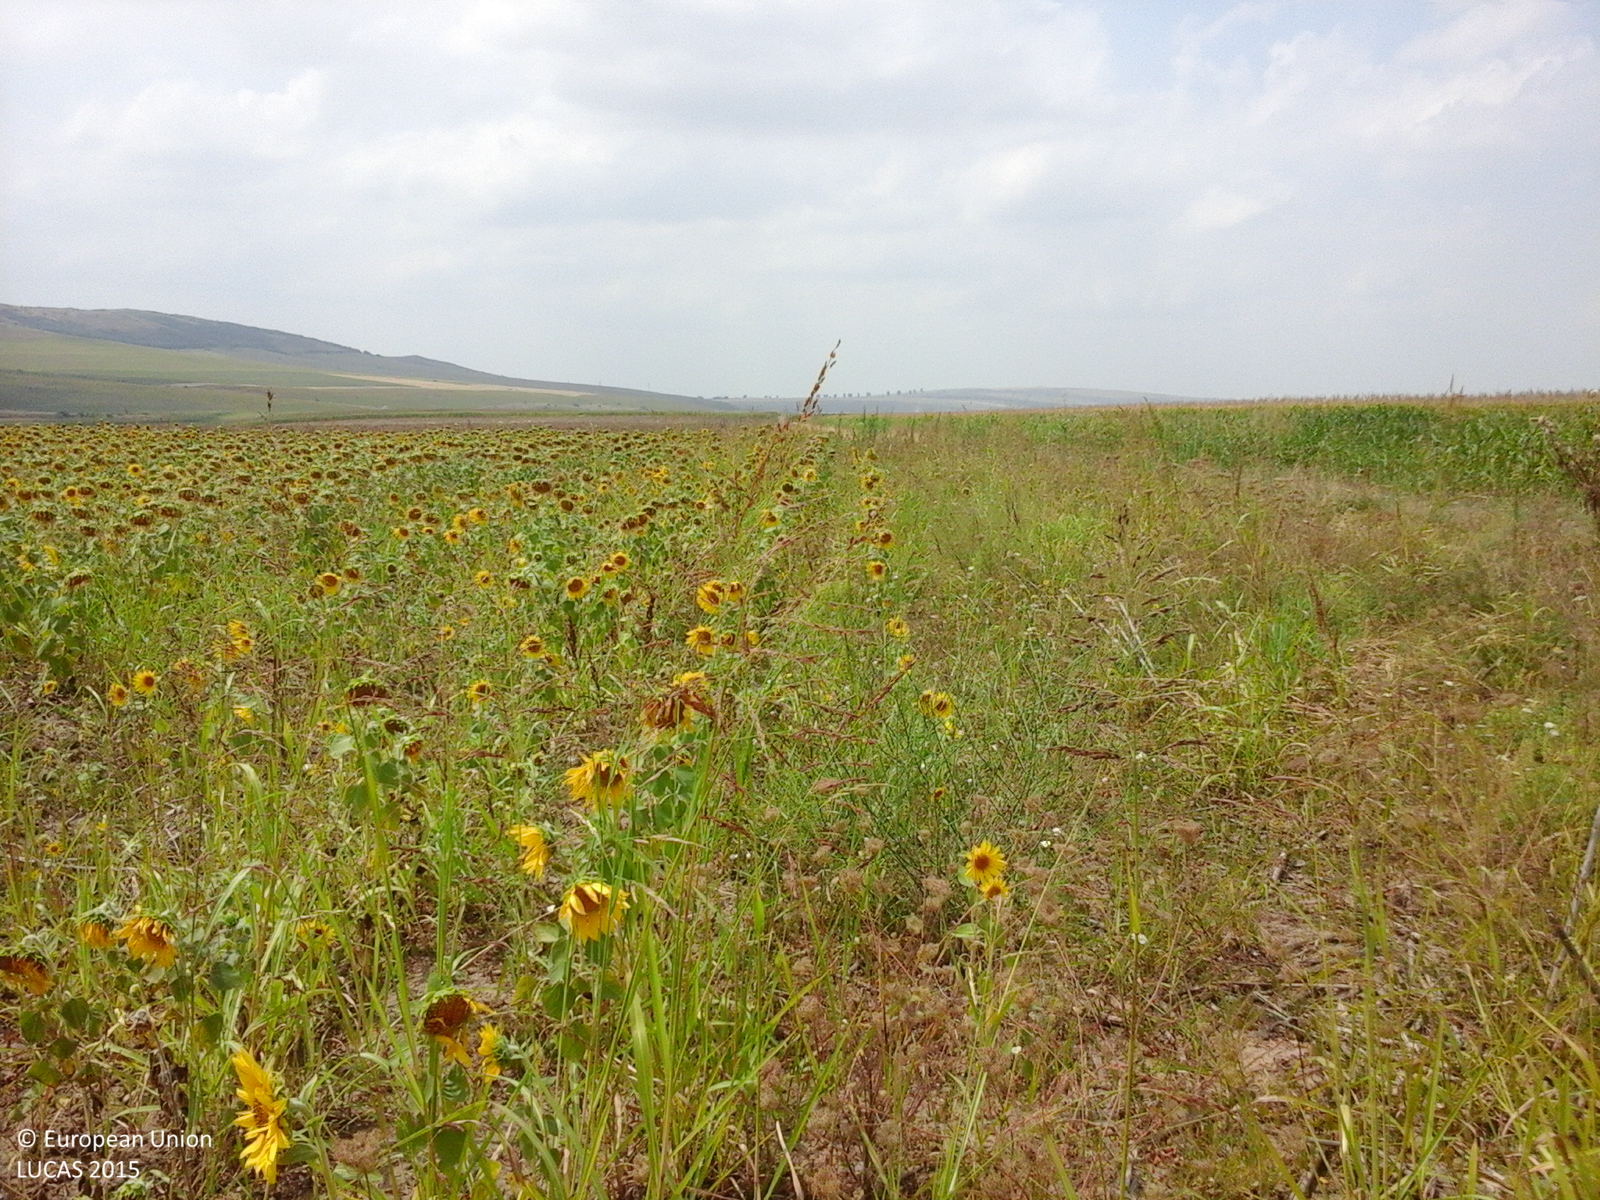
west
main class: Cropland
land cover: Sunflower
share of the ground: > 75 %
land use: Agriculture (excluding fallow land and kitchen gardens)
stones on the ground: < 10 %
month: July
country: RO
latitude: 44.9861
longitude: 28.2441
